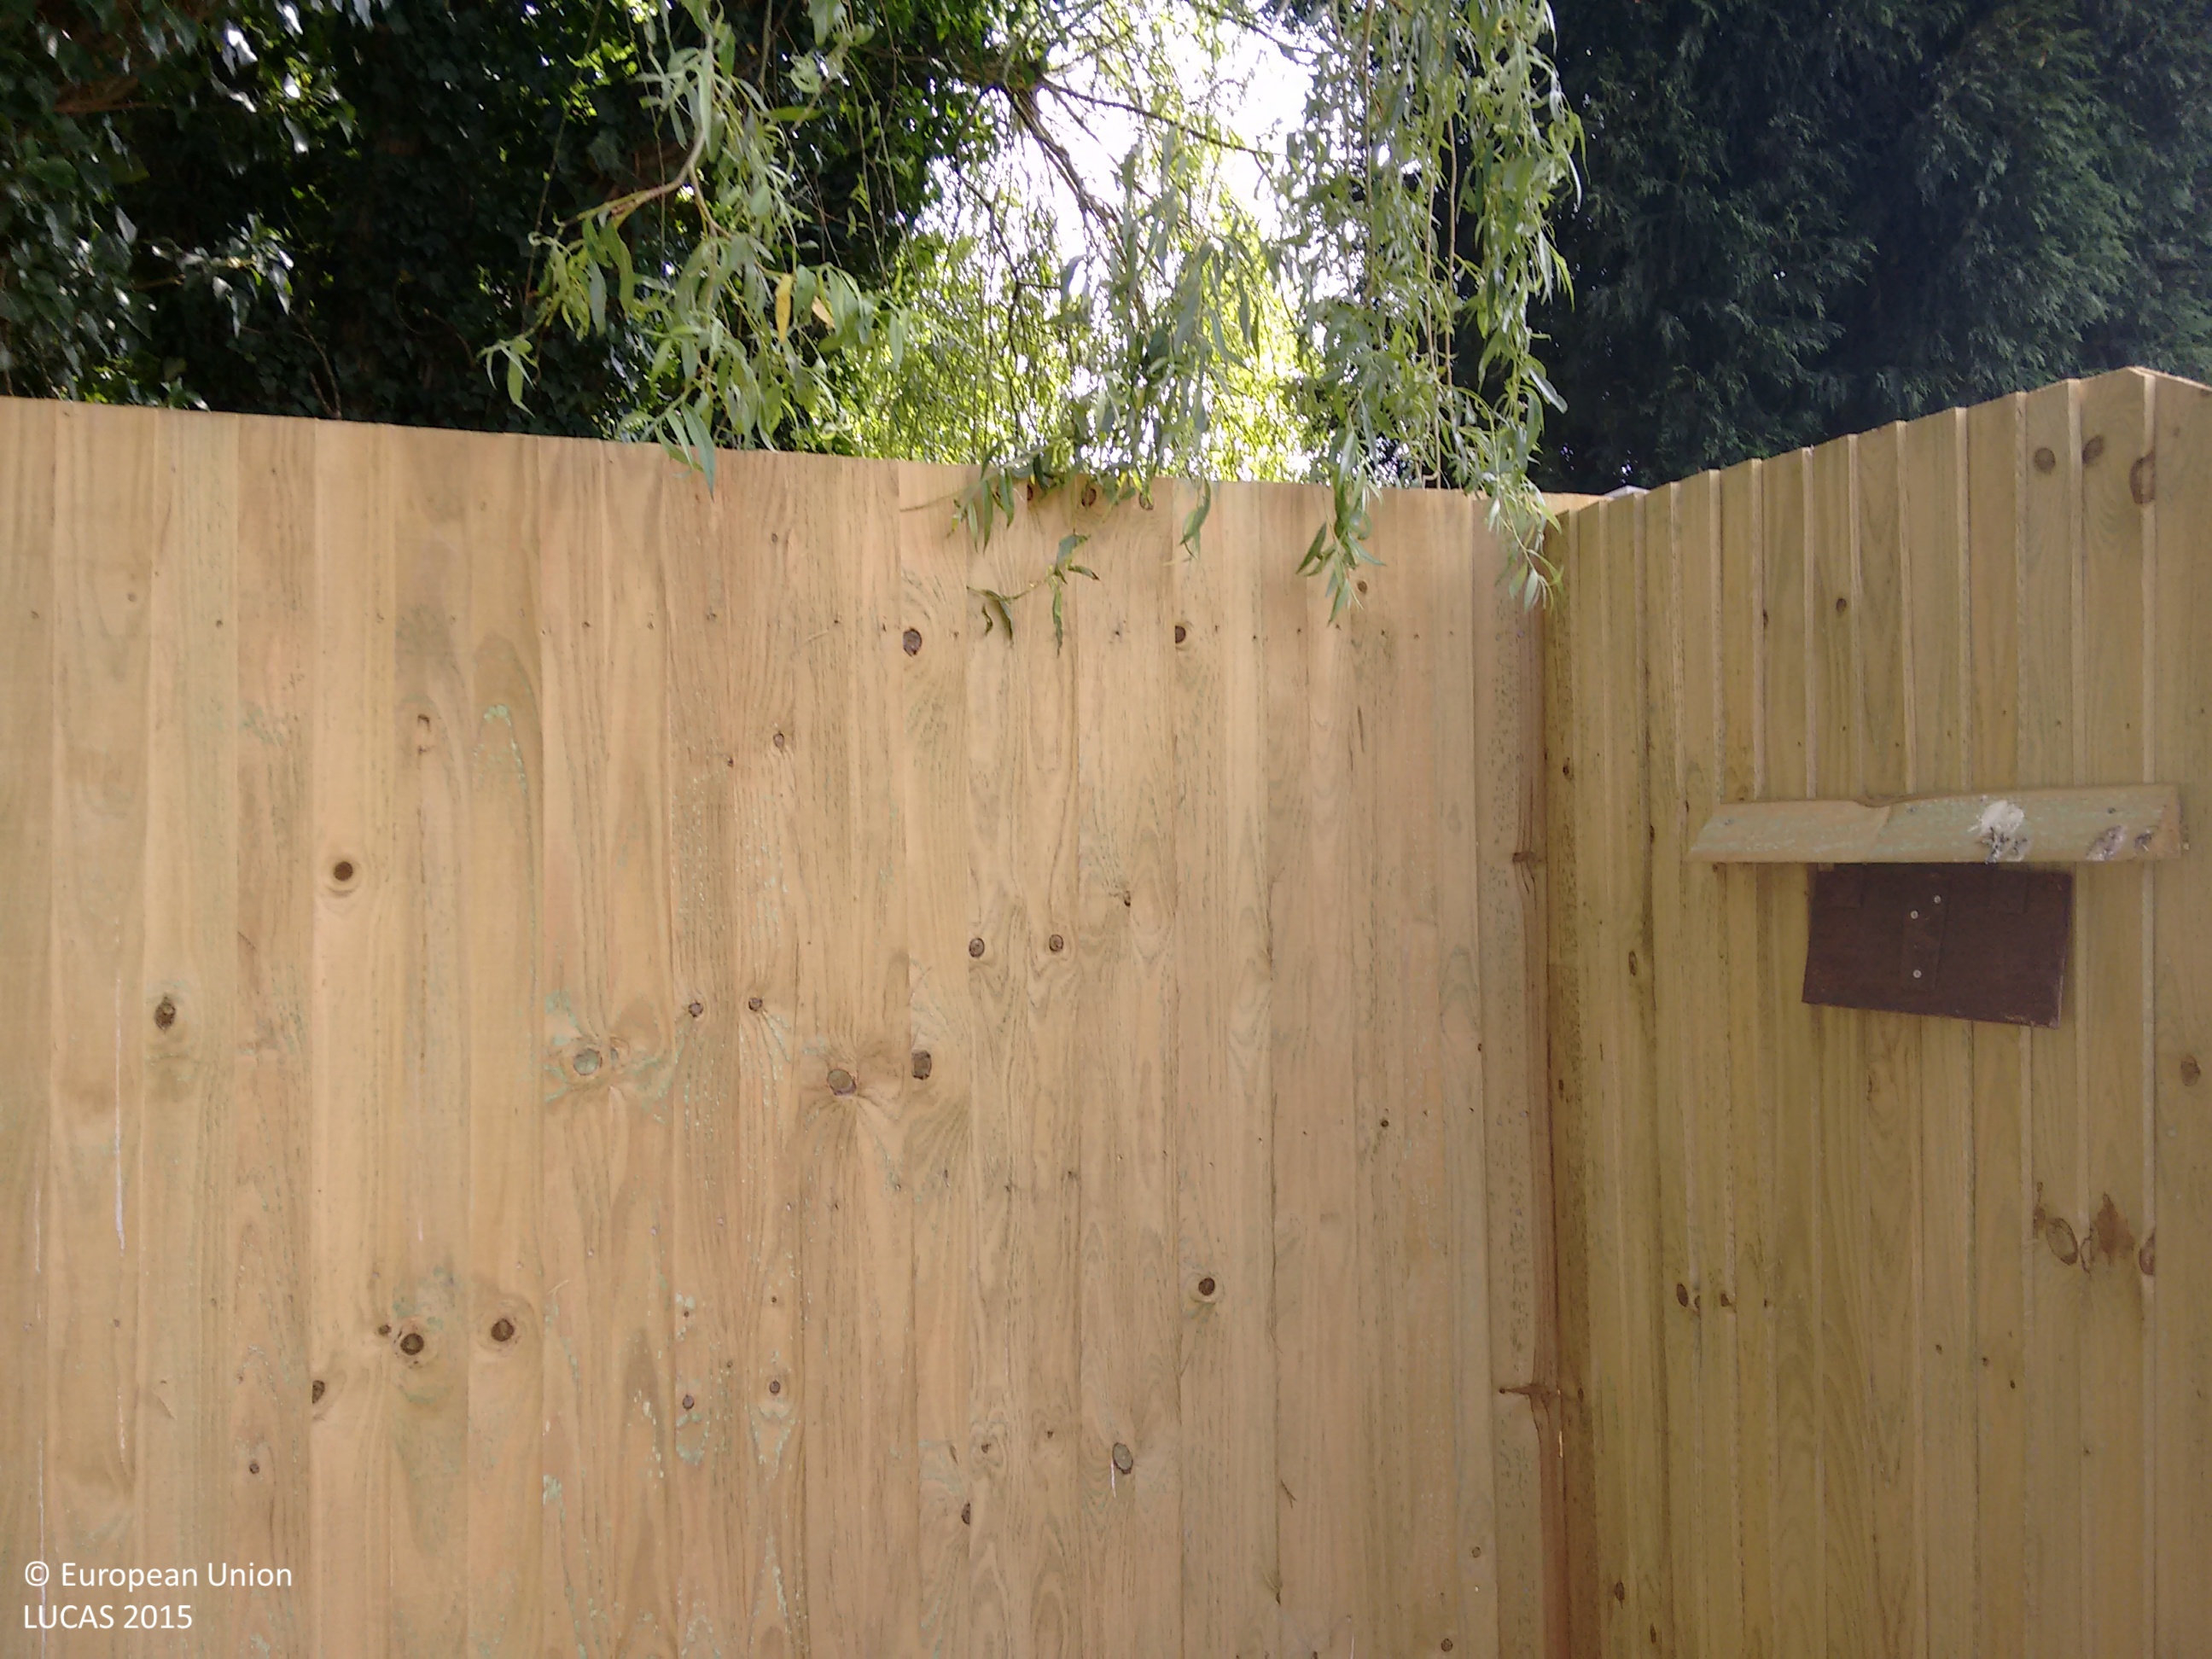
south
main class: Woodland
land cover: Broadleaved woodland
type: mesophytic deciduous forest
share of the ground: > 75 %
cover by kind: broadleaved forest trees 100 %
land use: Semi-natural and natural areas not in use
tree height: > 5 m
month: July
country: GB
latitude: 50.9570
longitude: -0.4157
